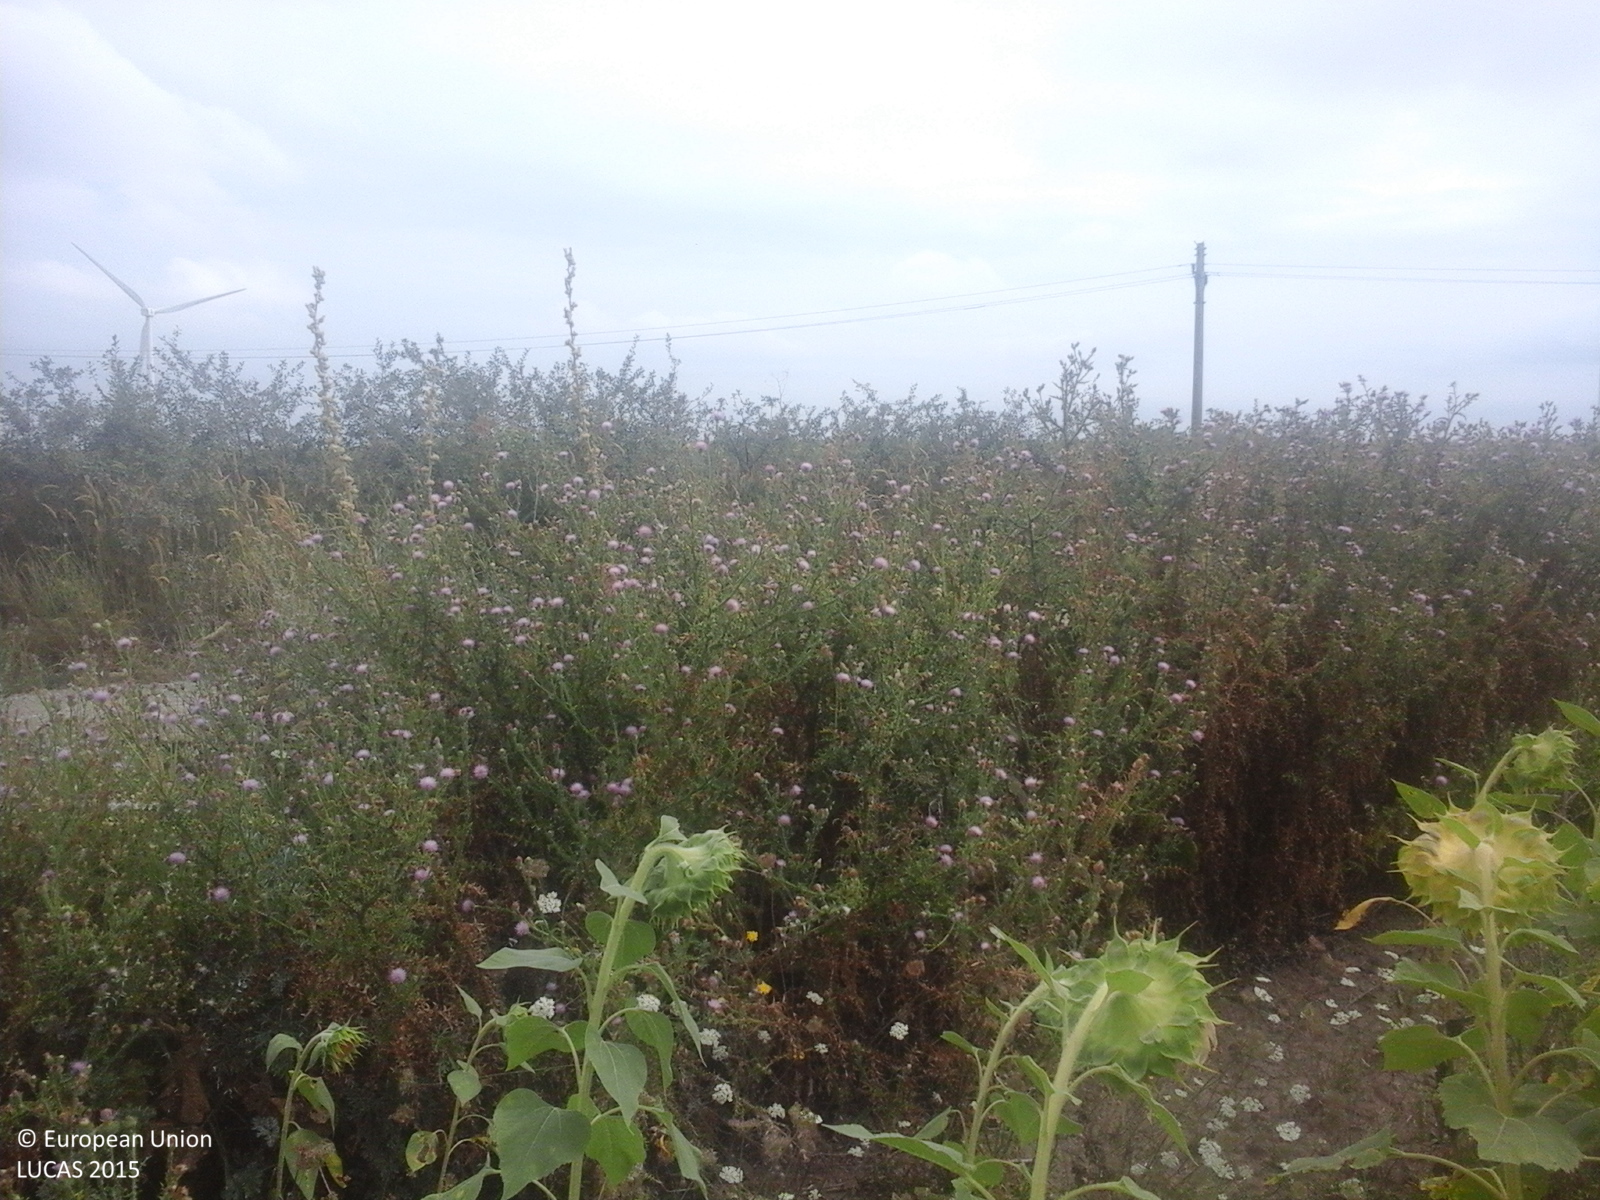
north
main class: Cropland
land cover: Sunflower
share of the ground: > 75 %
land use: Agriculture (excluding fallow land and kitchen gardens)
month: August
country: RO
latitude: 44.7857
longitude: 28.3337
